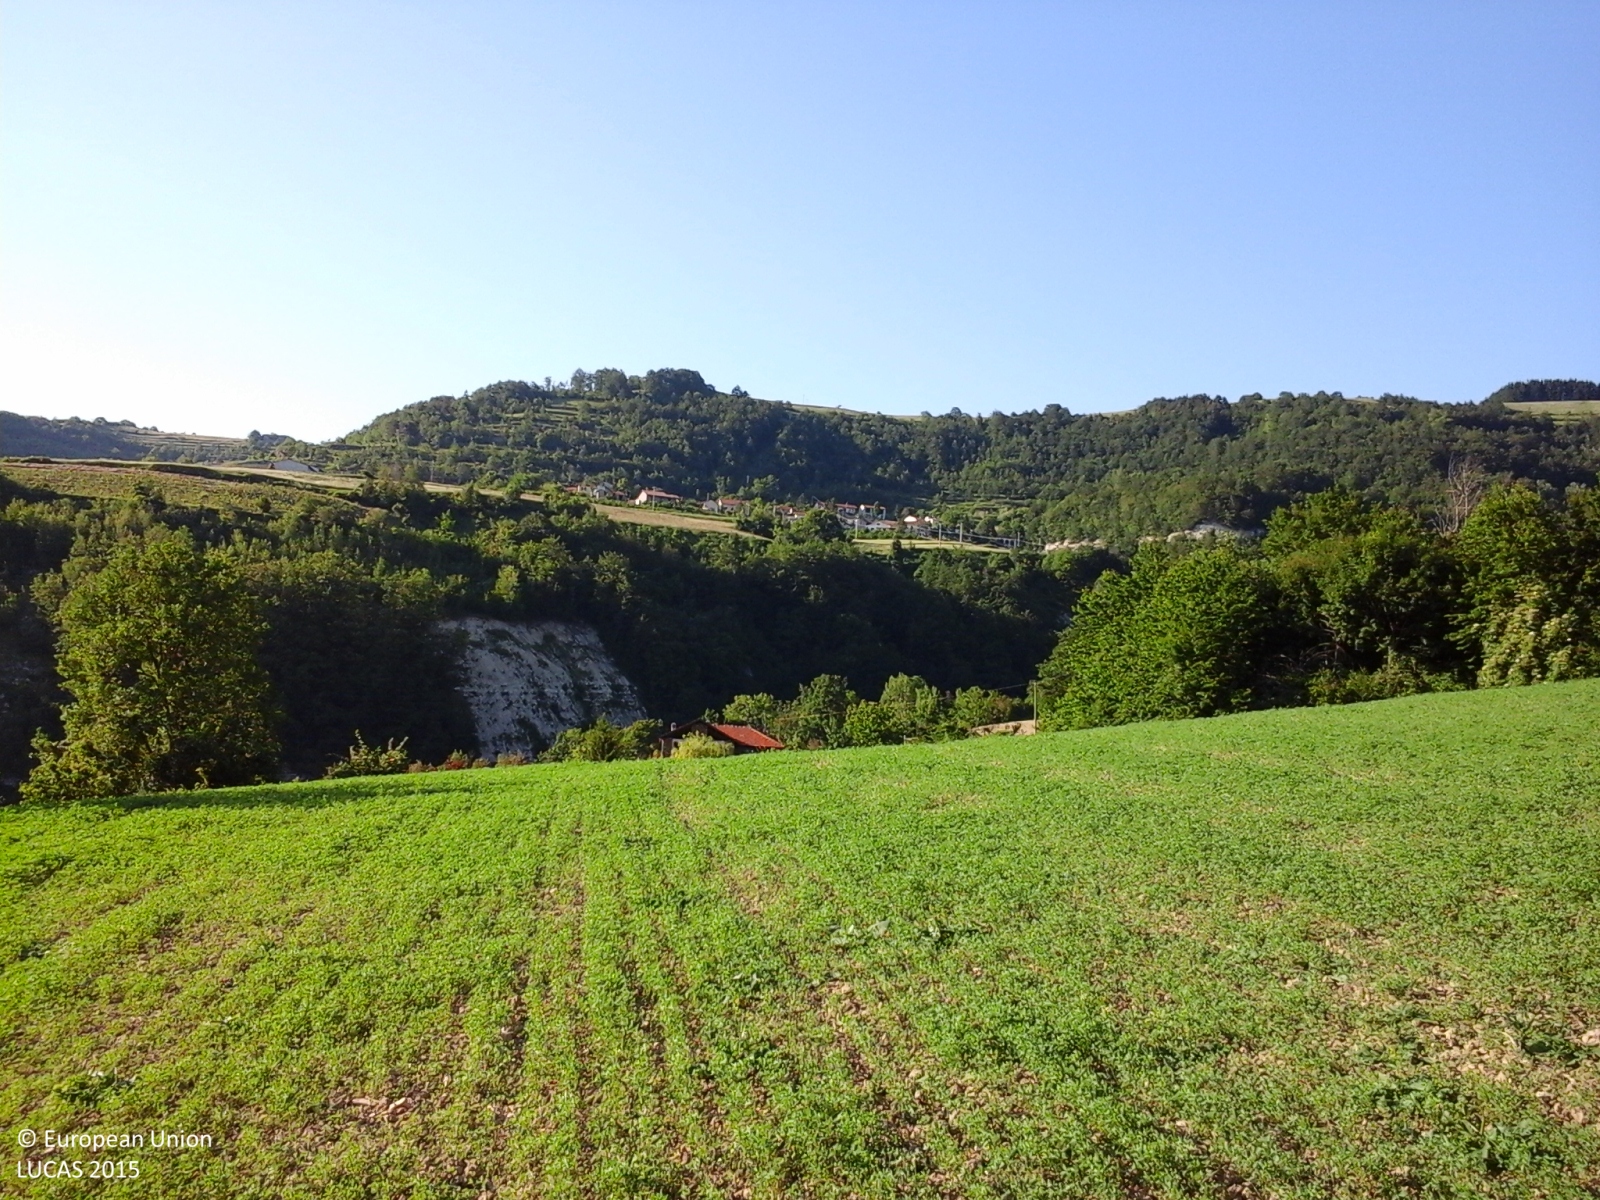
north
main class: Cropland
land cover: Lucerne
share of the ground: > 75 %
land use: Agriculture (excluding fallow land and kitchen gardens)
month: June
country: IT
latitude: 44.5523
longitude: 8.2539
